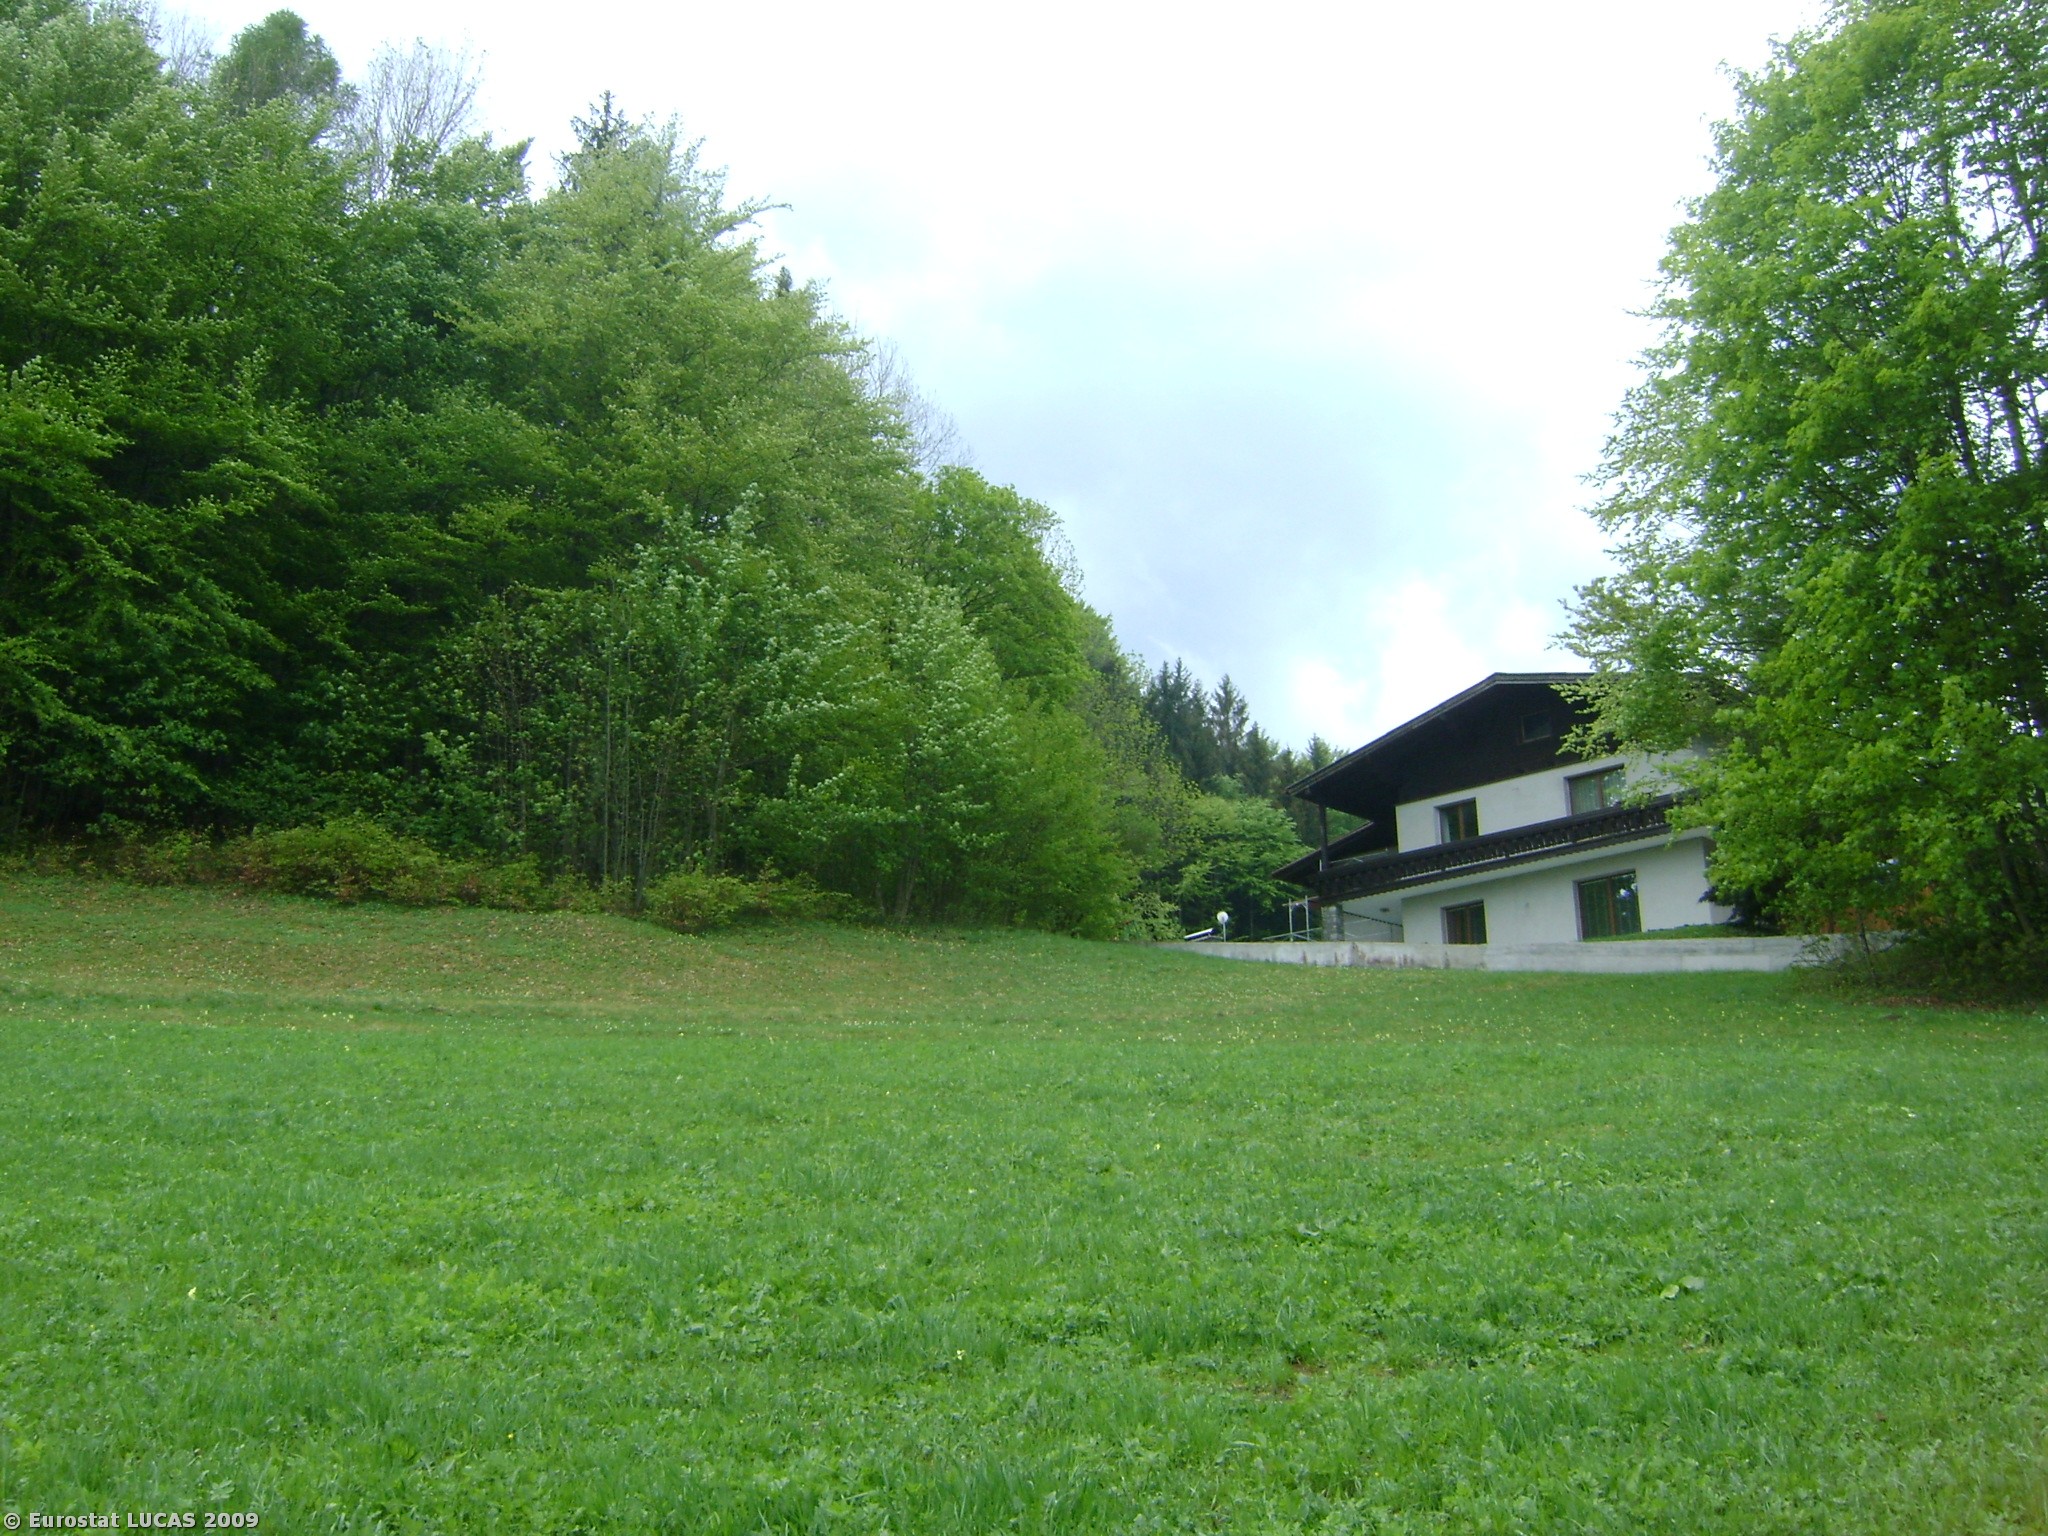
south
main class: Grassland
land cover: Grassland without tree/shrub cover
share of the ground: > 75 %
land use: Agriculture (excluding fallow land and kitchen gardens)
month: May
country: AT
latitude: 47.8164
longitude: 13.2173
